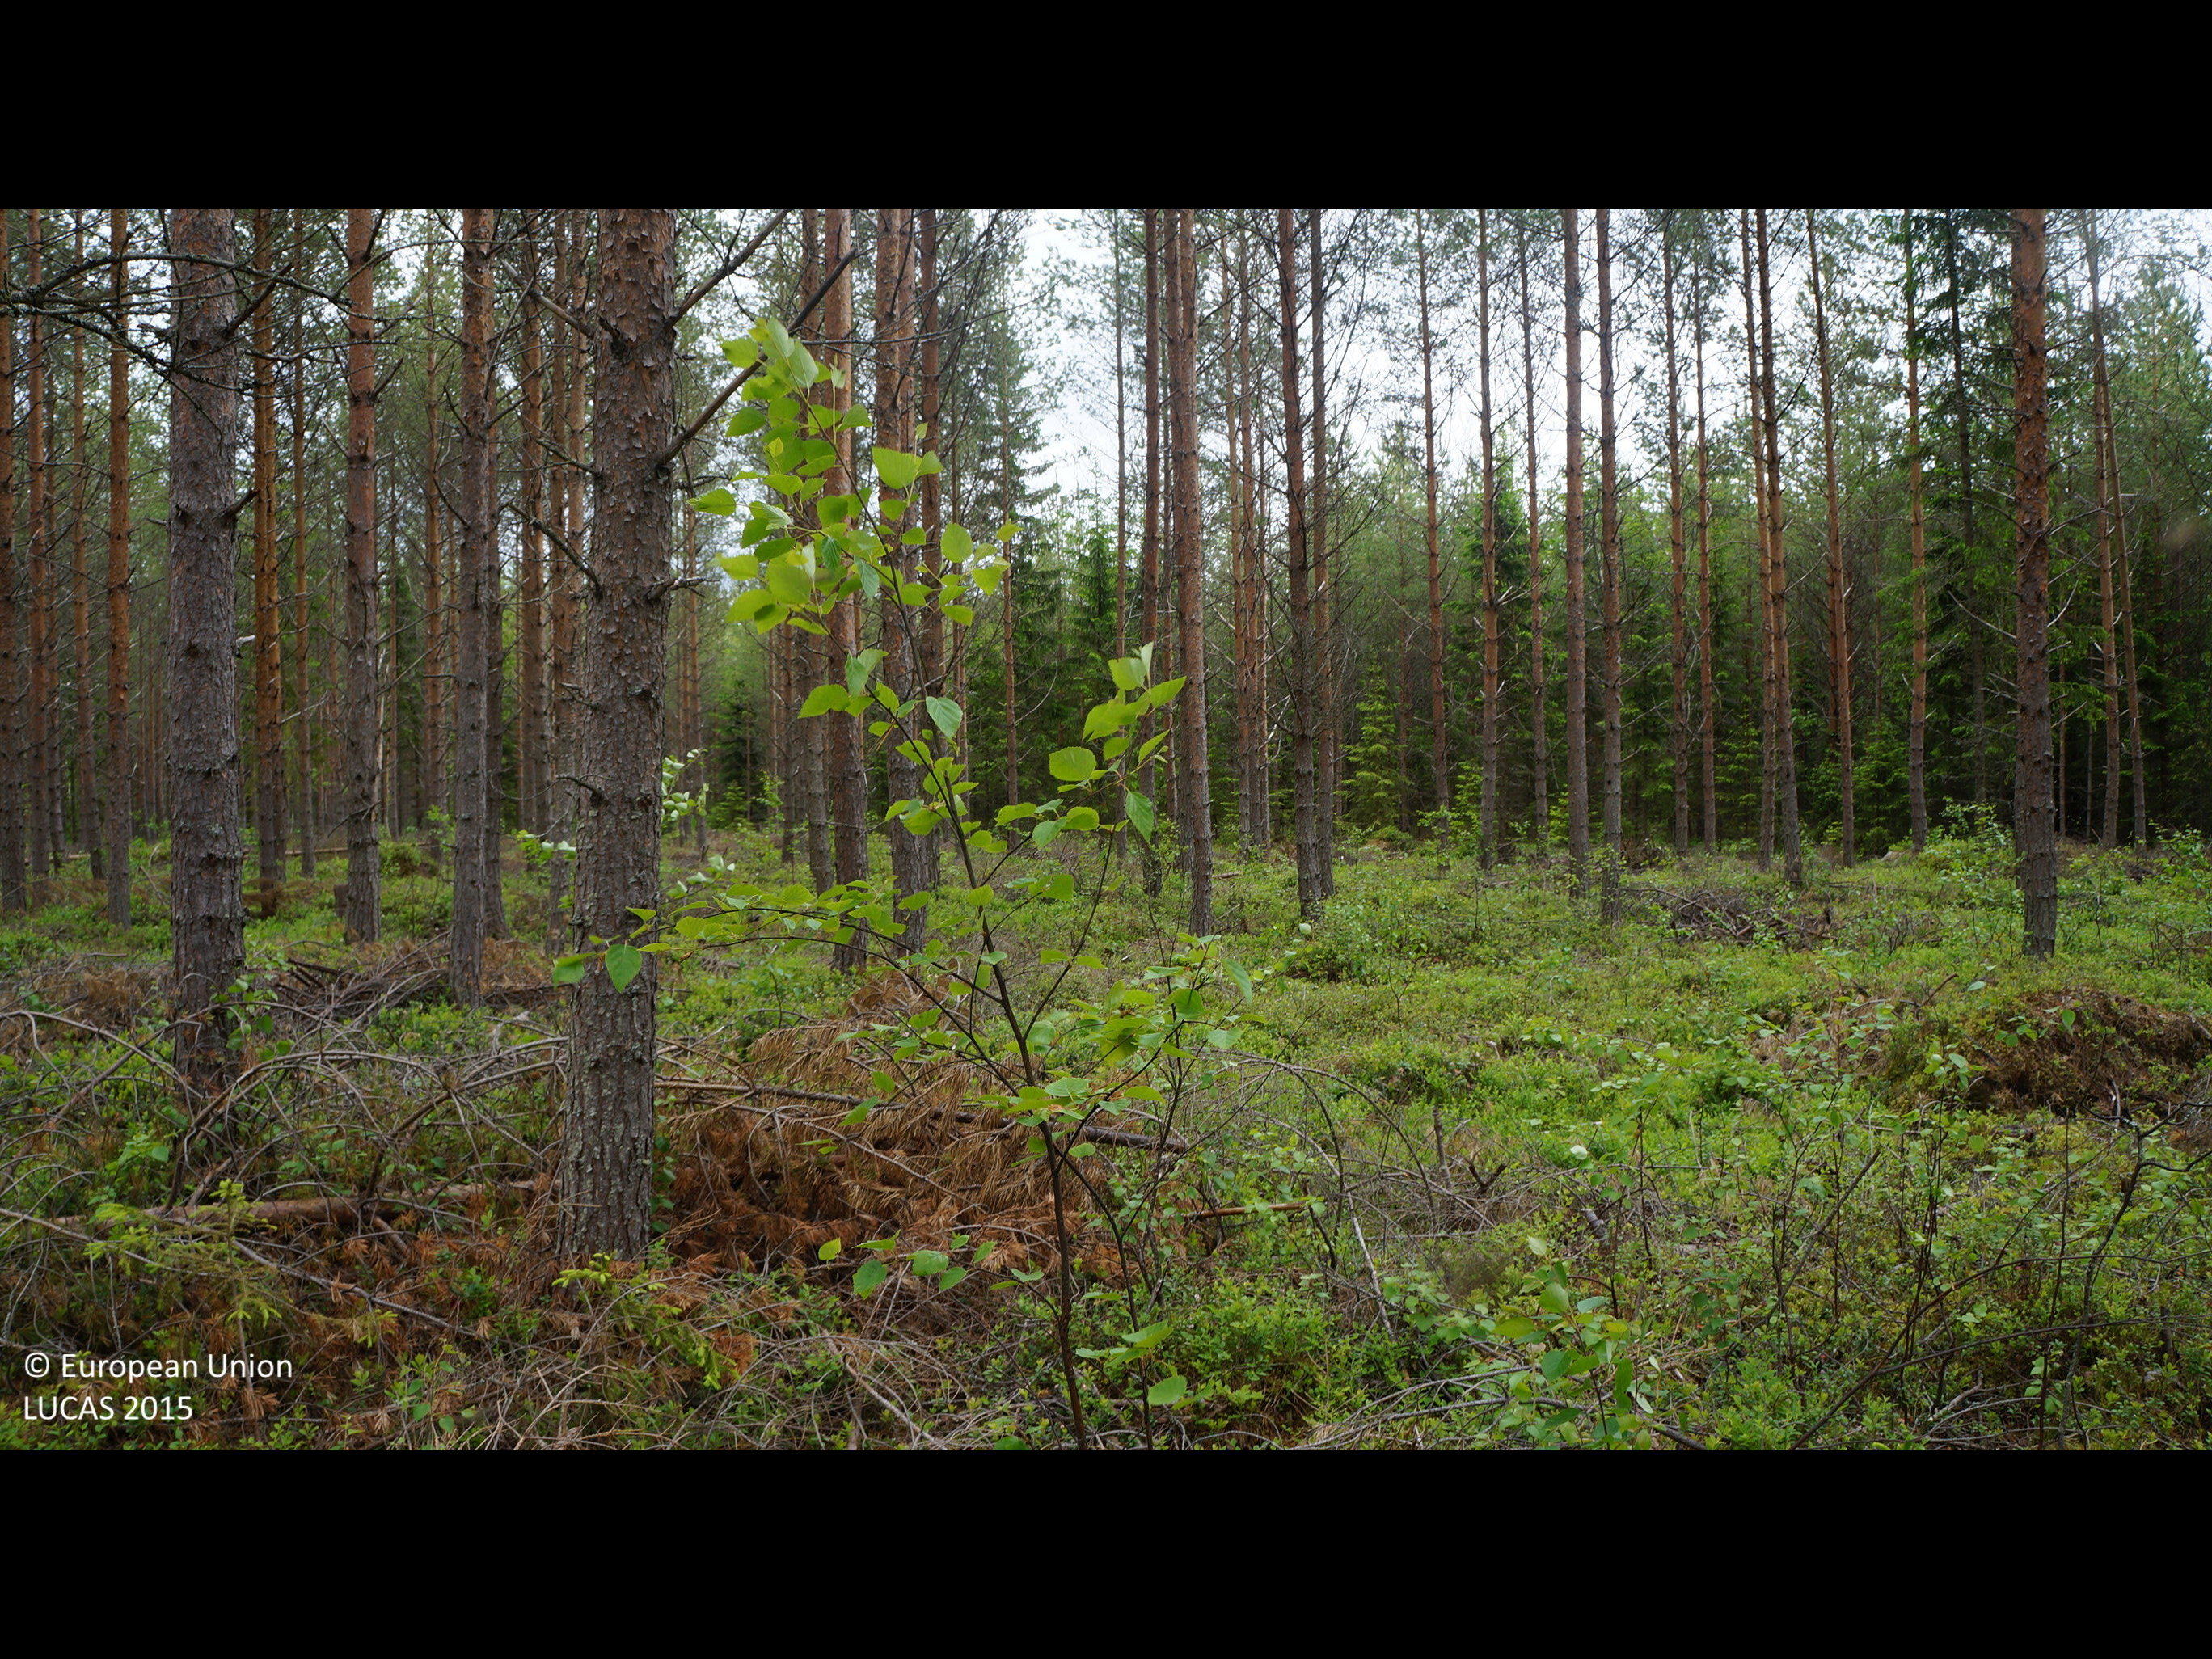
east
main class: Woodland
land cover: Pine dominated coniferous woodland
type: boreal forest
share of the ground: 50 - 75 %
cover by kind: coniferous forest trees 60 %, shrubs 20 %, lichens and mosses 15 %, consolidated bare surface 5 %
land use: Forestry
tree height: > 5 m
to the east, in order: Pine dominated coniferous woodland; Tracks; Pine dominated coniferous woodland; Pine dominated mixed woodland; Ditches and canals; Grass margins; Paved roads, cycling and walking lanes; Grass margins; Ditches and canals; Other mixed woodland
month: June
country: FI
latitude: 63.8995
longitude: 23.1937
